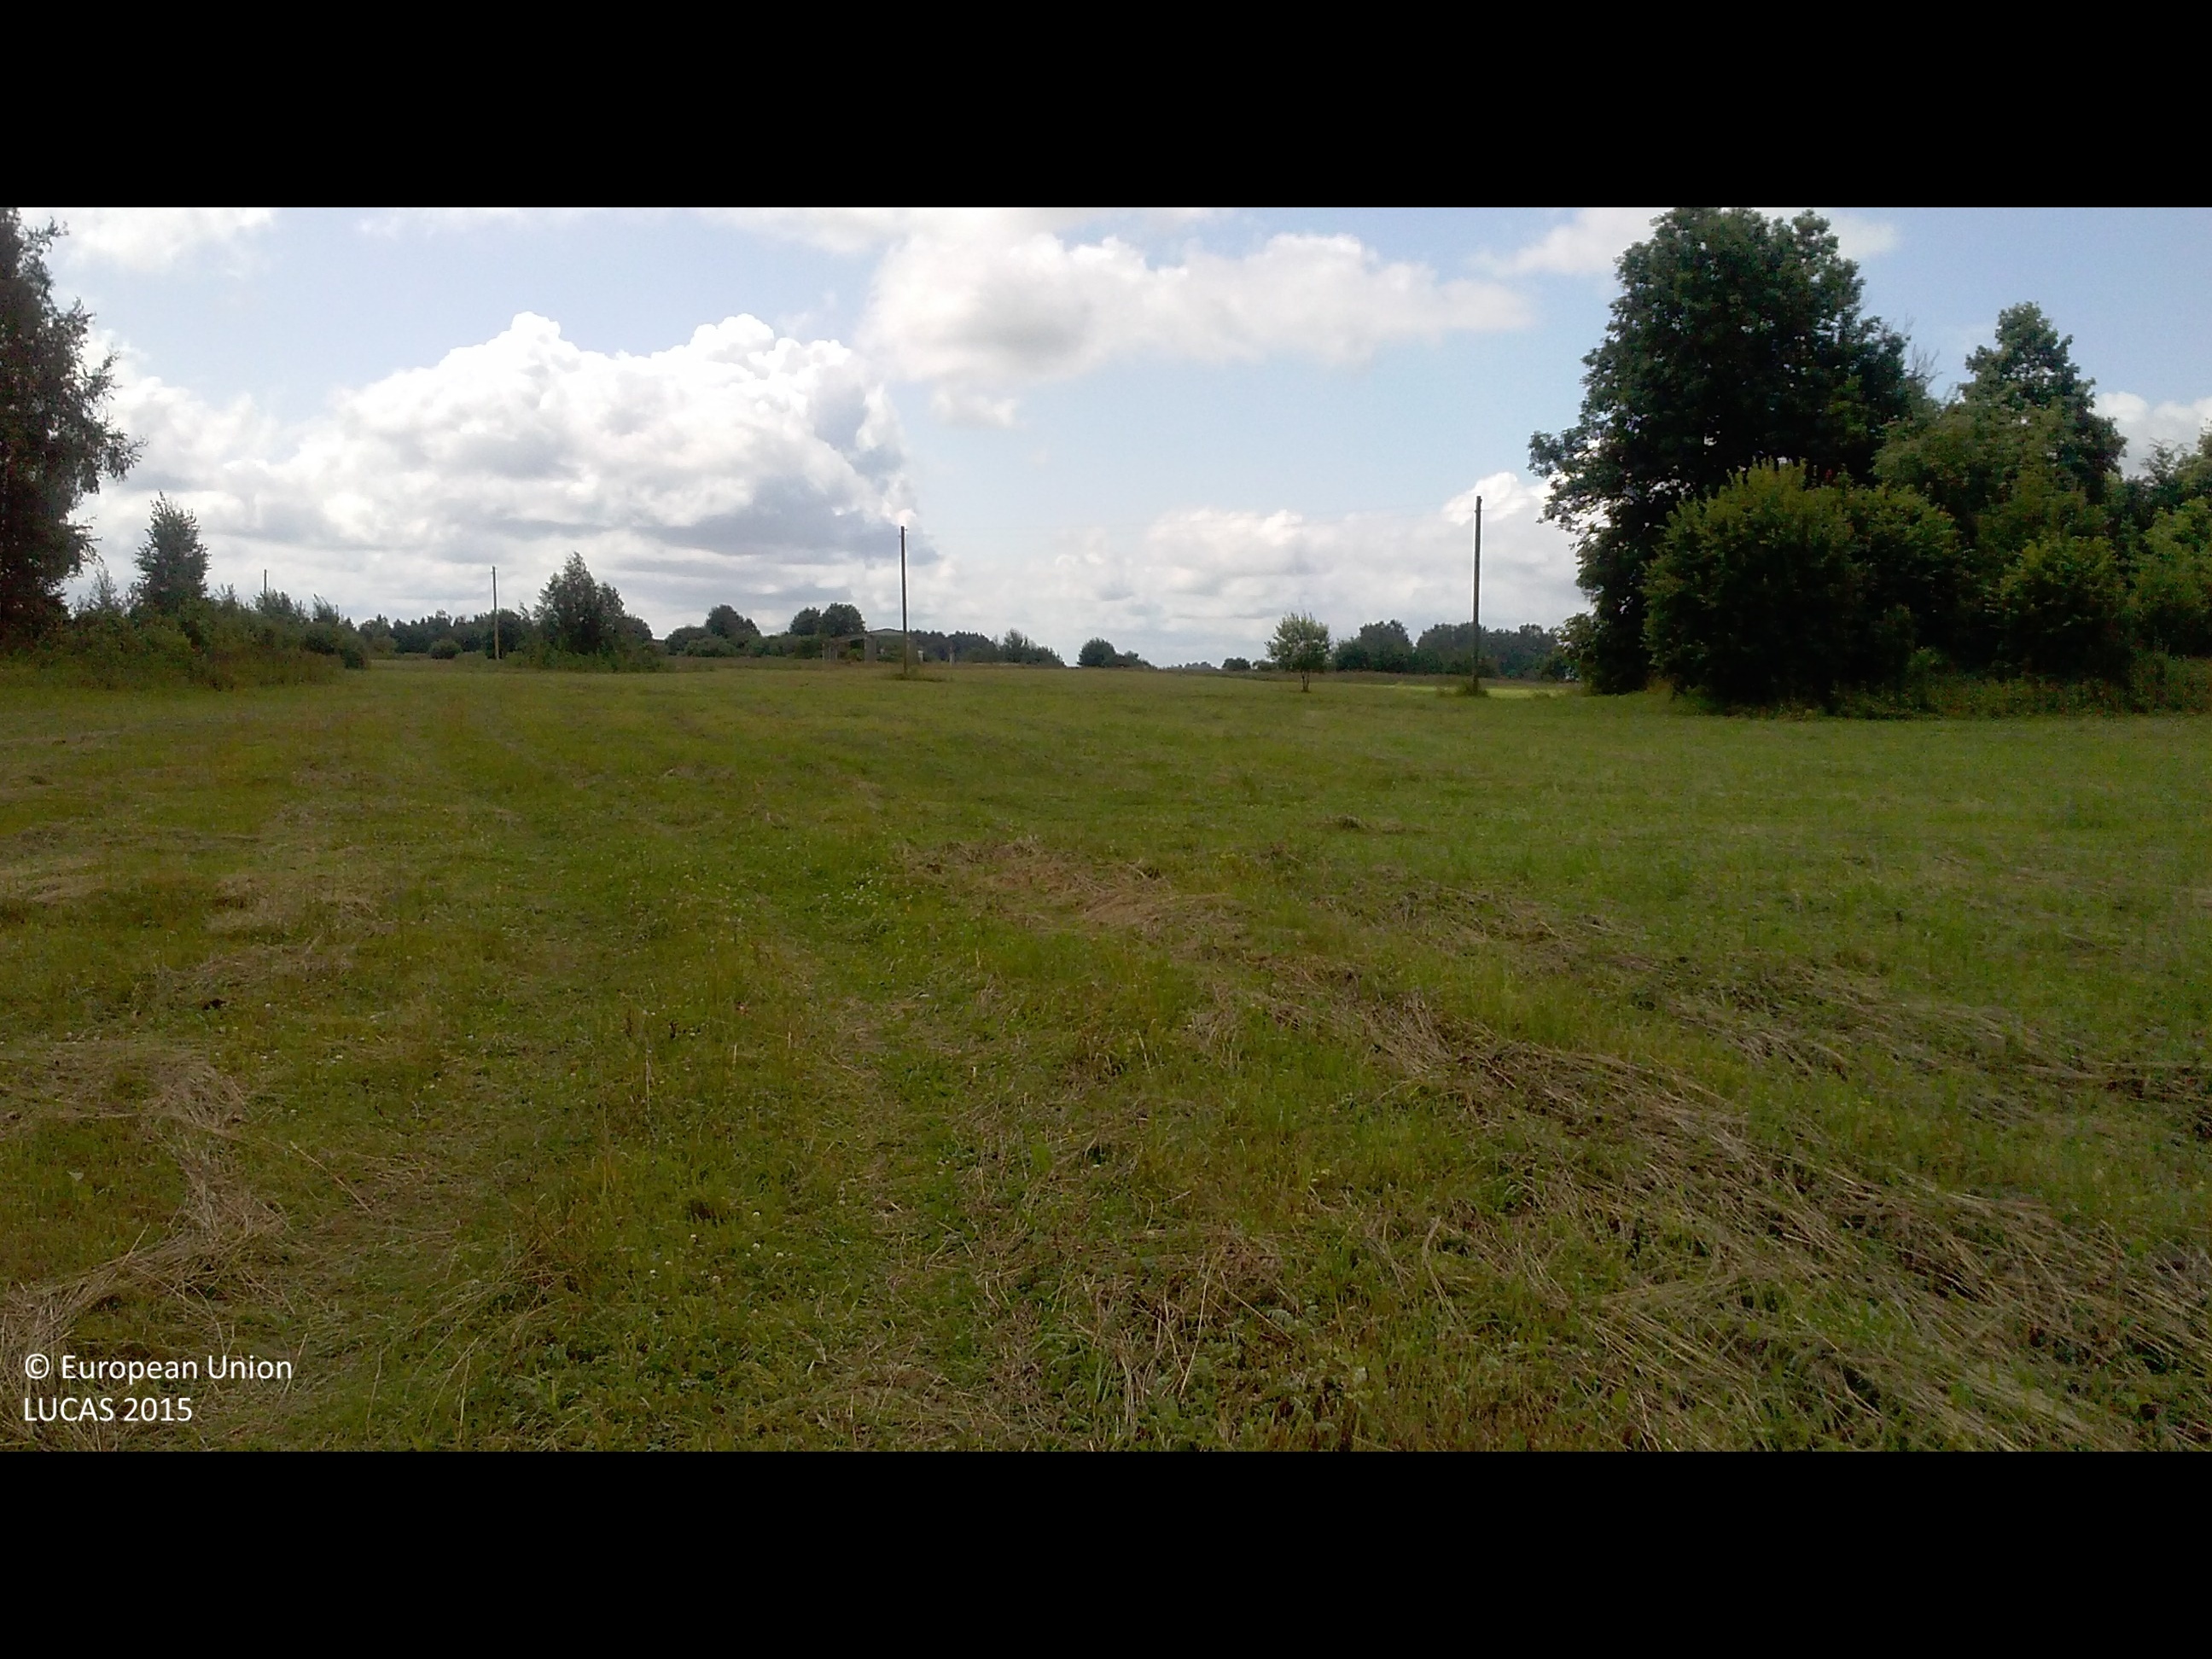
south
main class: Grassland
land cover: Grassland without tree/shrub cover
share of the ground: > 75 %
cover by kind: herbaceous plants 95 %, unconsolidated bare surface 5 %
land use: Agriculture (excluding fallow land and kitchen gardens)
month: July
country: LV
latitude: 56.4781
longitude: 26.9999
